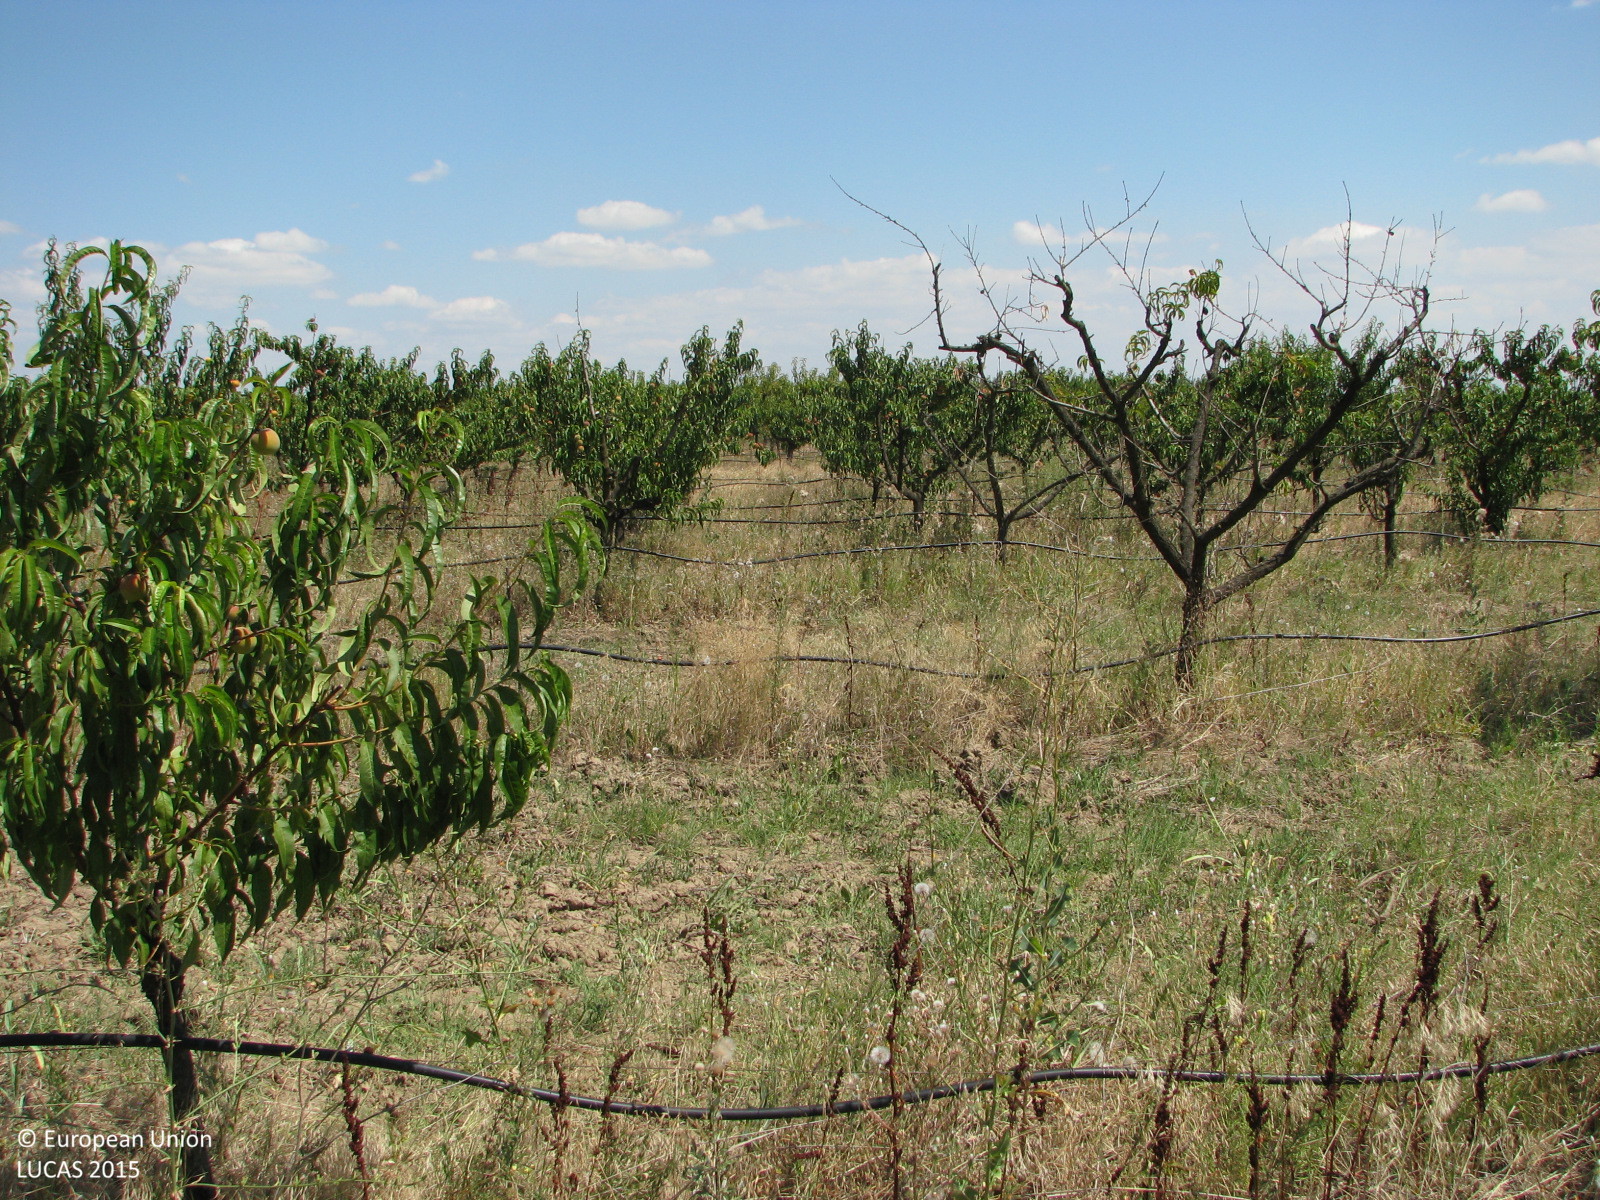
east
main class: Cropland
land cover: Other fruit trees and berries
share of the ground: 25 - 50 %
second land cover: Spontaneously vegetated surfaces
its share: > 75 %
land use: Agriculture (excluding fallow land and kitchen gardens)
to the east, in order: Other fruit trees and berries; Spontaneously vegetated surfaces; Tracks; Other fruit trees and berries; Tracks; Other fruit trees and berries
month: July
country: BG
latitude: 42.5728
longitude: 26.3038
